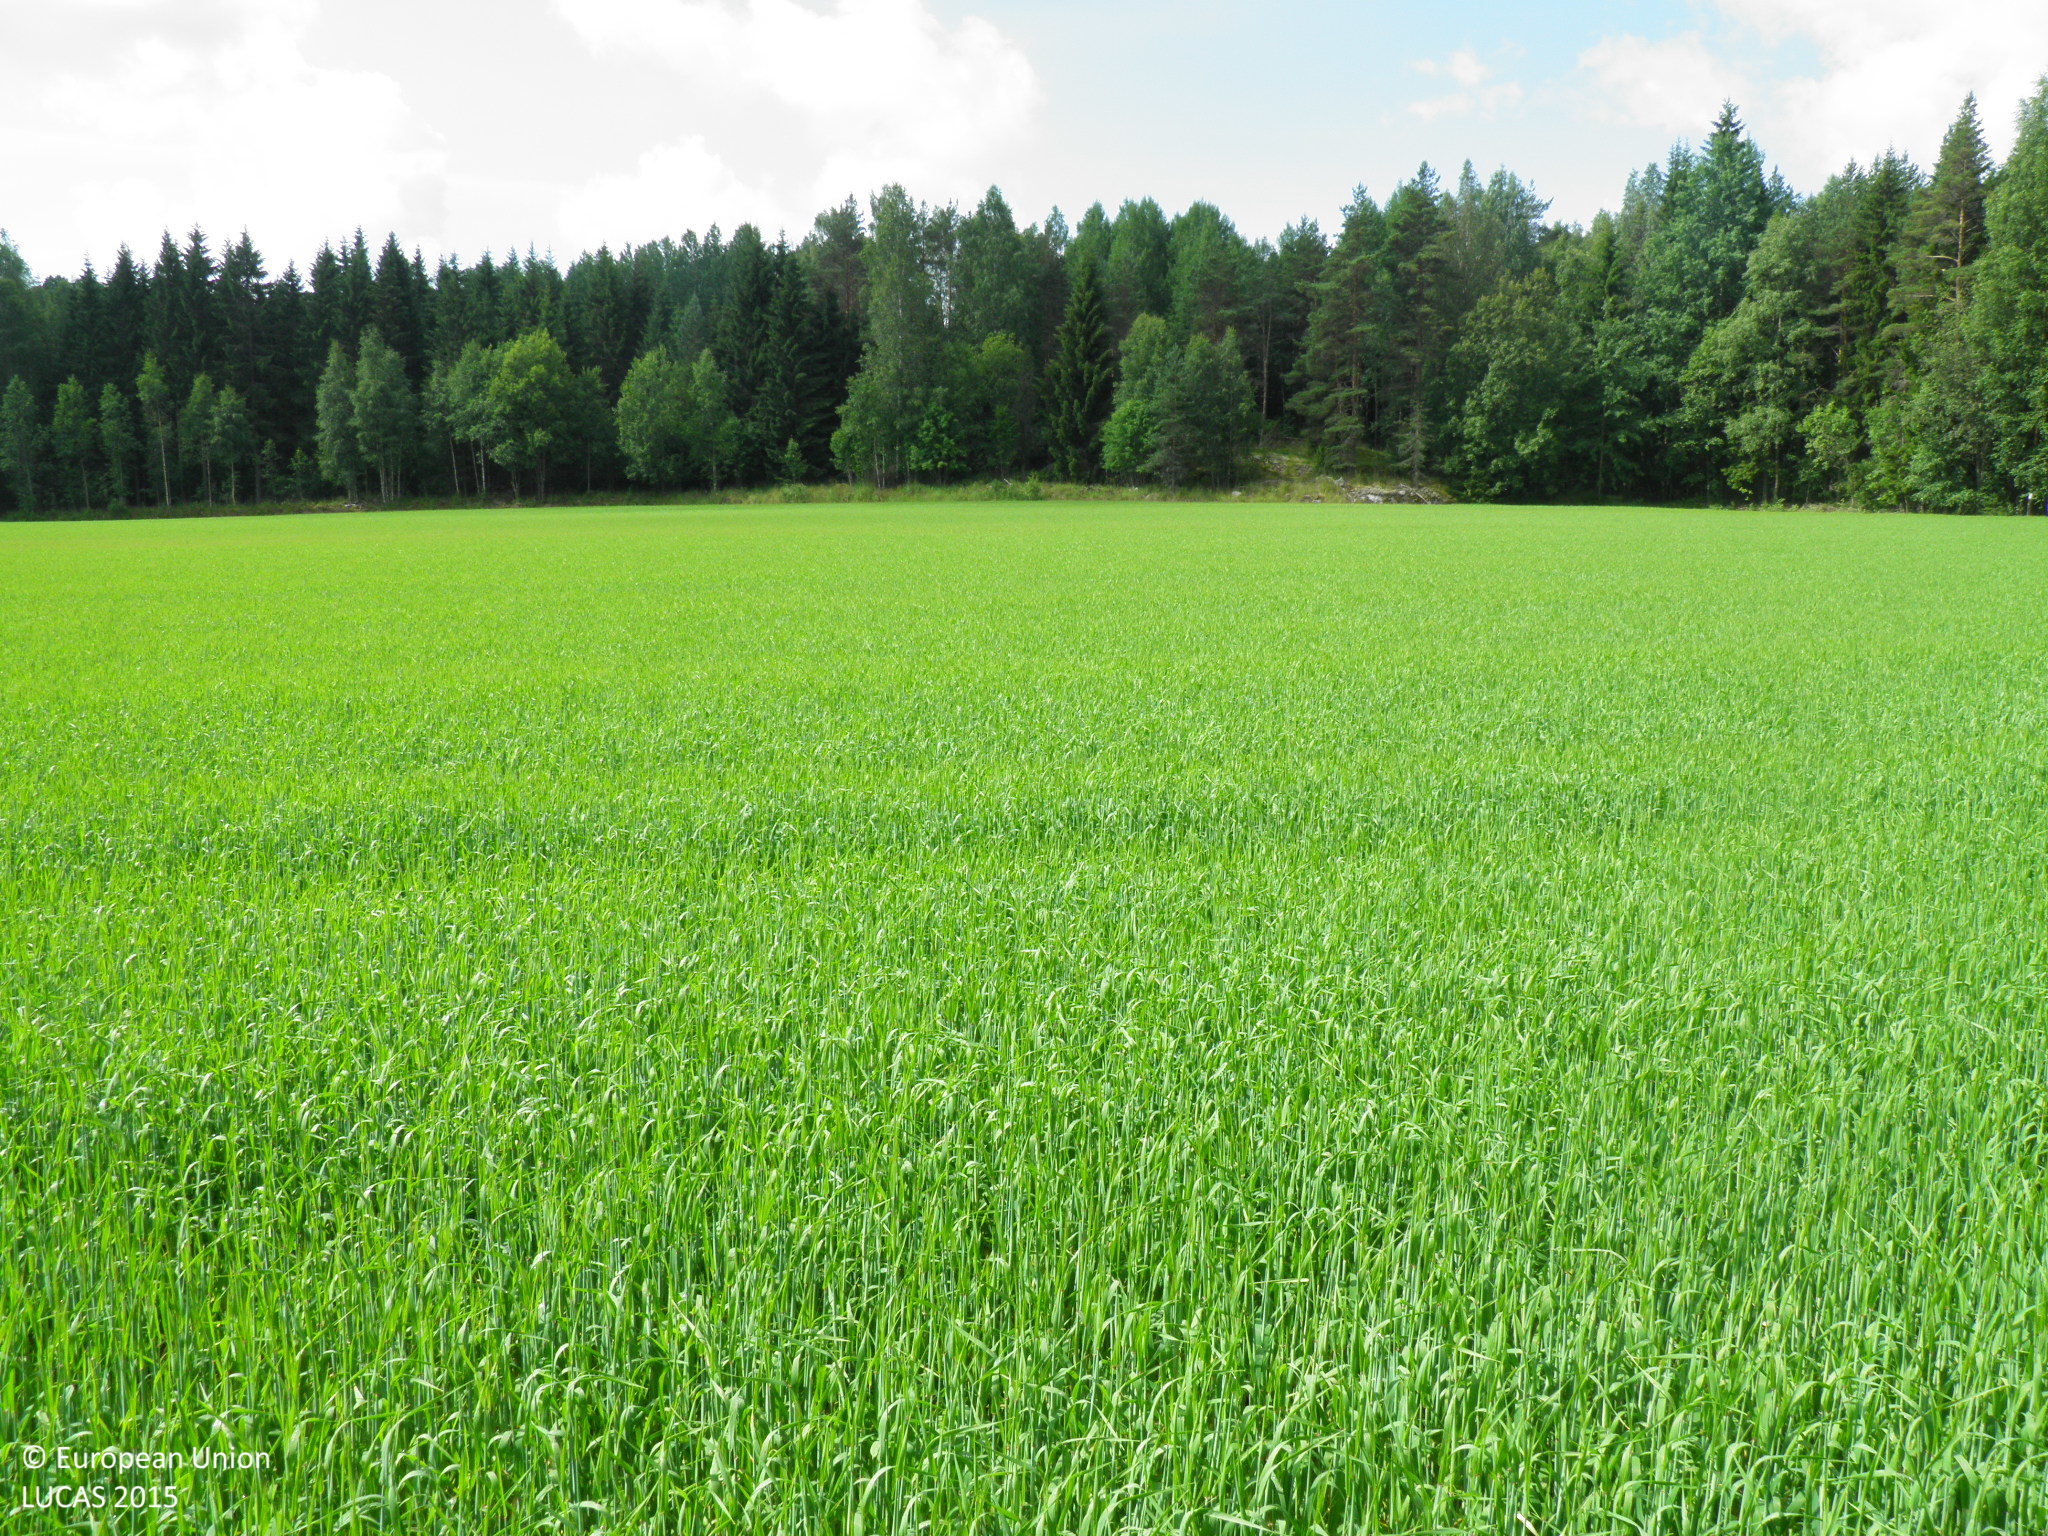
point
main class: Cropland
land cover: Barley
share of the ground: > 75 %
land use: Agriculture (excluding fallow land and kitchen gardens)
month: July
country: FI
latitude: 60.7292
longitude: 22.3696
